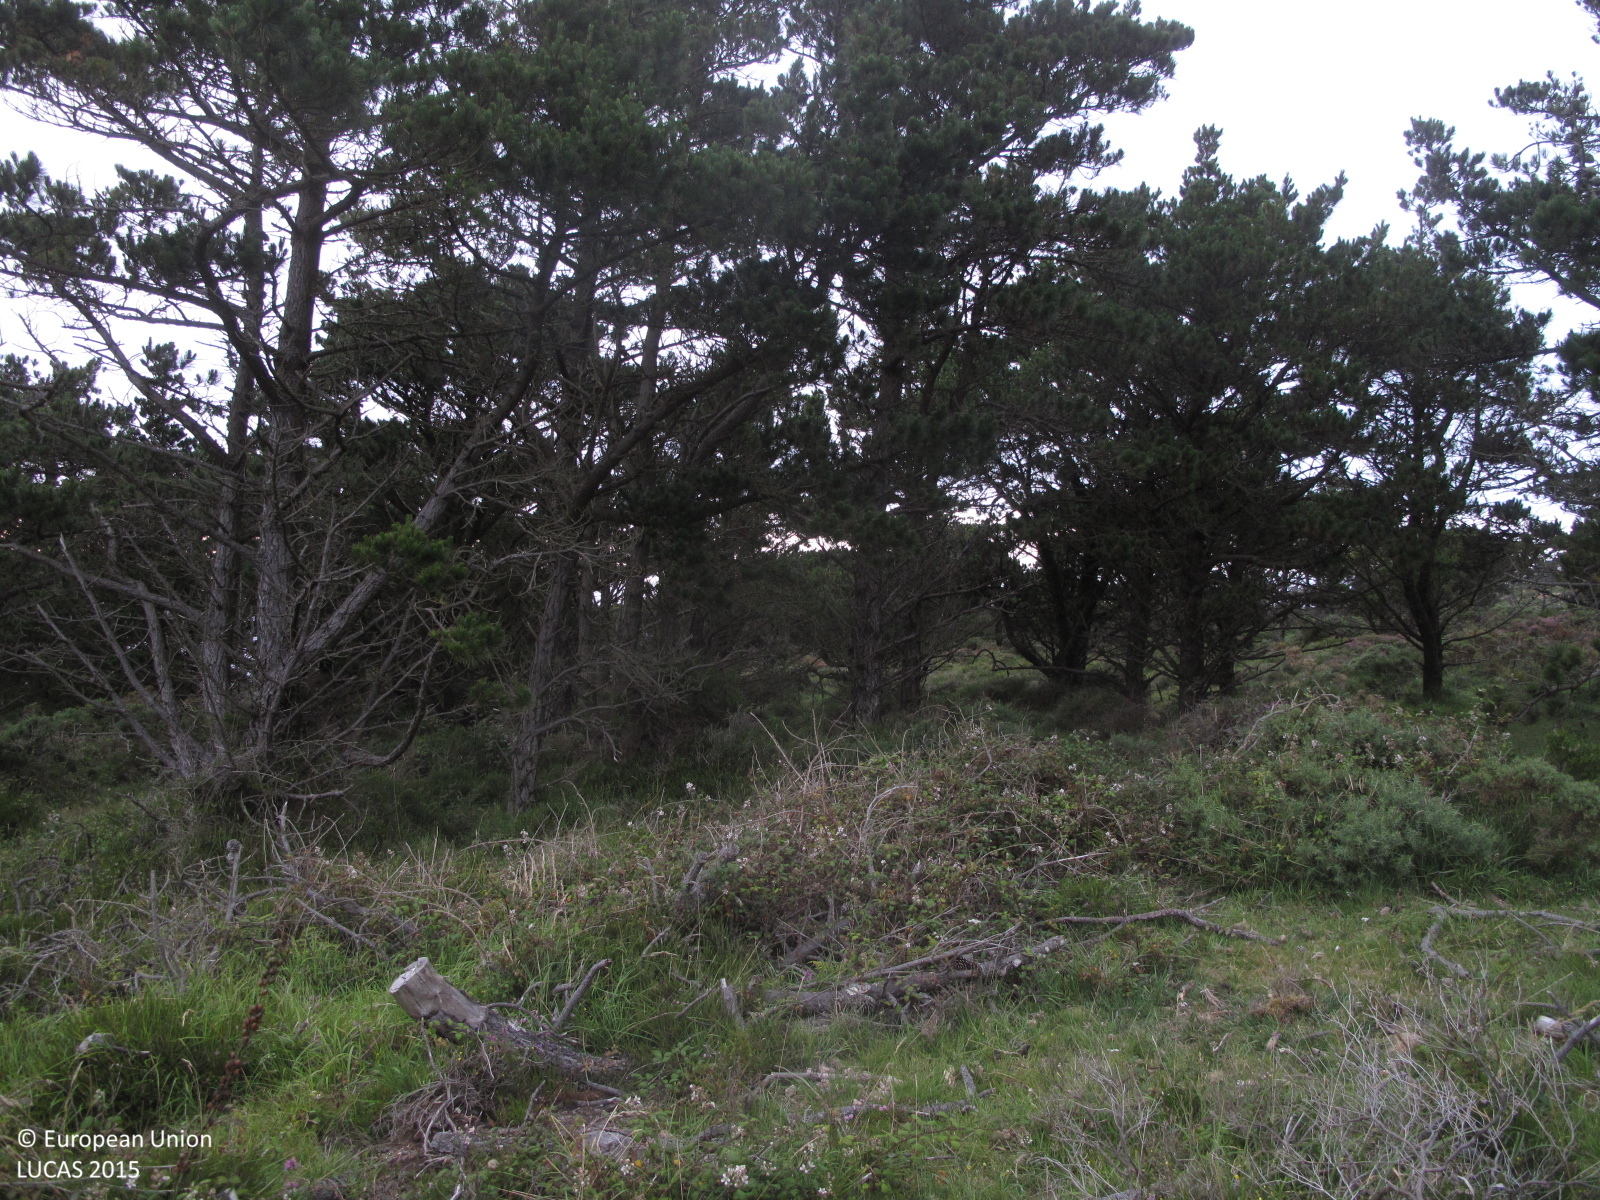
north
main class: Woodland
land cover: Pine dominated coniferous woodland
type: exotic forest
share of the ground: 25 - 50 %
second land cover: Shrubland without tree cover
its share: 10 - 25 %
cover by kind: coniferous forest trees 40 %, herbaceous plants 40 %, shrubs 20 %
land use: Forestry
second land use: Agriculture (excluding fallow land and kitchen gardens)
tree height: > 5 m
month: July
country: ES
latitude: 43.7569
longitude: -7.8942
